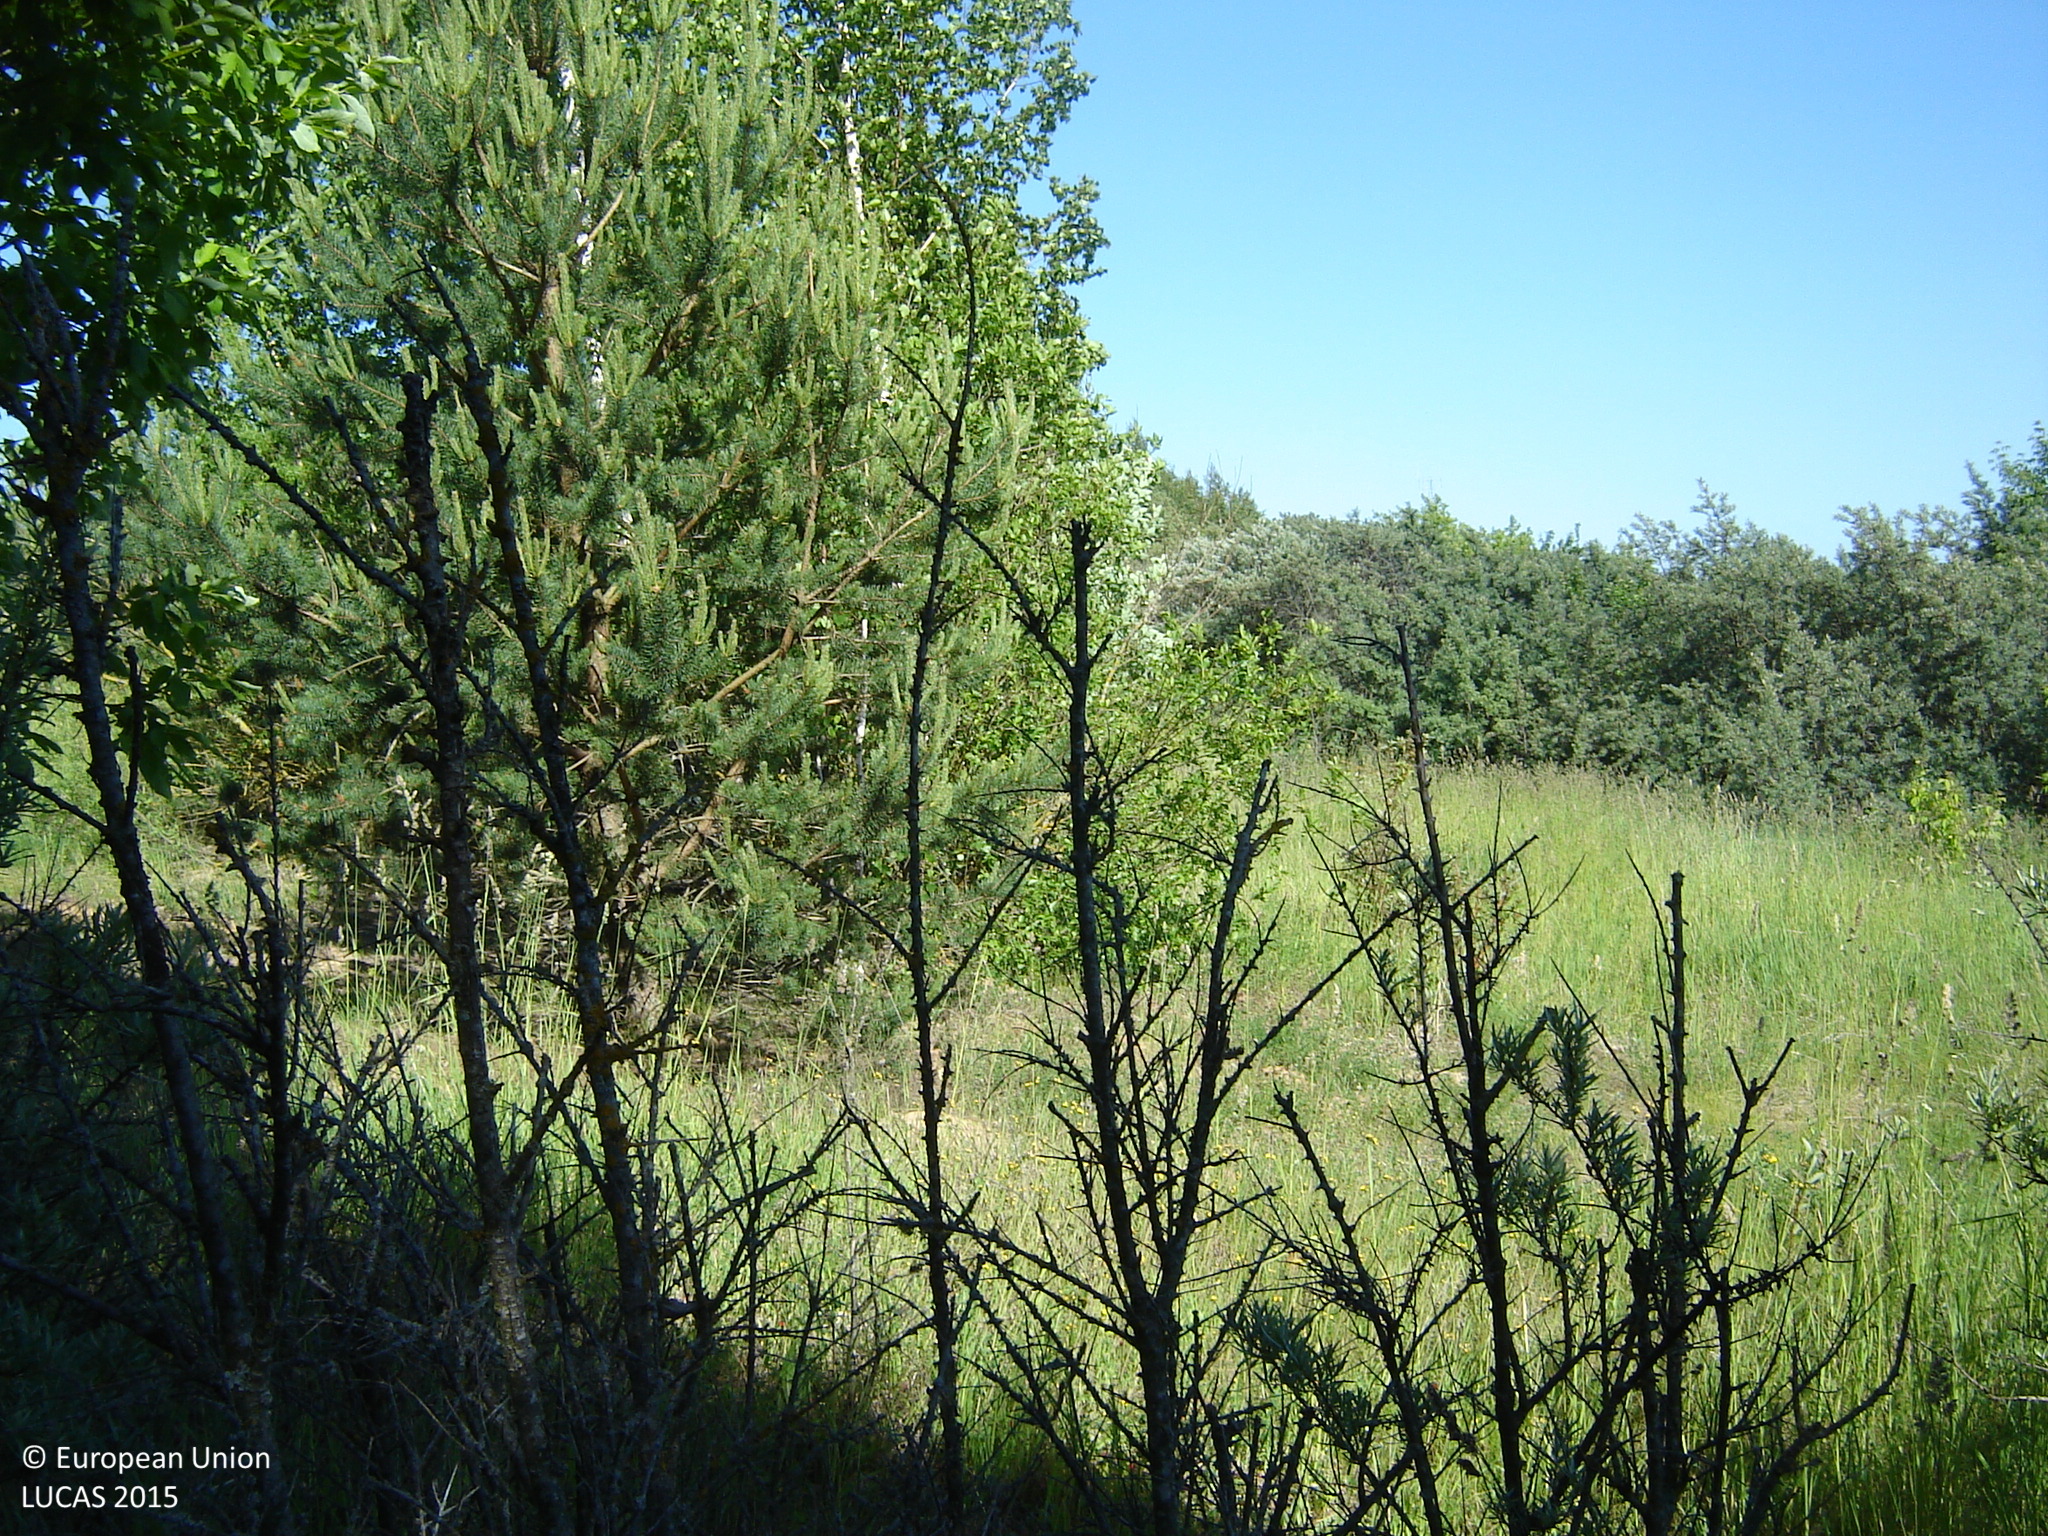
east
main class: Woodland
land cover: Broadleaved woodland
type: non-riverine alder, birch or aspen forest
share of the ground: > 75 %
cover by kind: broadleaved forest trees 75 %, herbaceous plants 20 %, shrubs 5 %
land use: Semi-natural and natural areas not in use
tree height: > 5 m
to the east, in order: Broadleaved woodland; Grassland without tree/shrub cover; Paved roads, cycling and walking lanes; Grassland without tree/shrub cover; Paved roads, cycling and walking lanes; Grassland with sparse tree/shrub cover
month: June
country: LT
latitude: 55.5269
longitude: 25.0840
